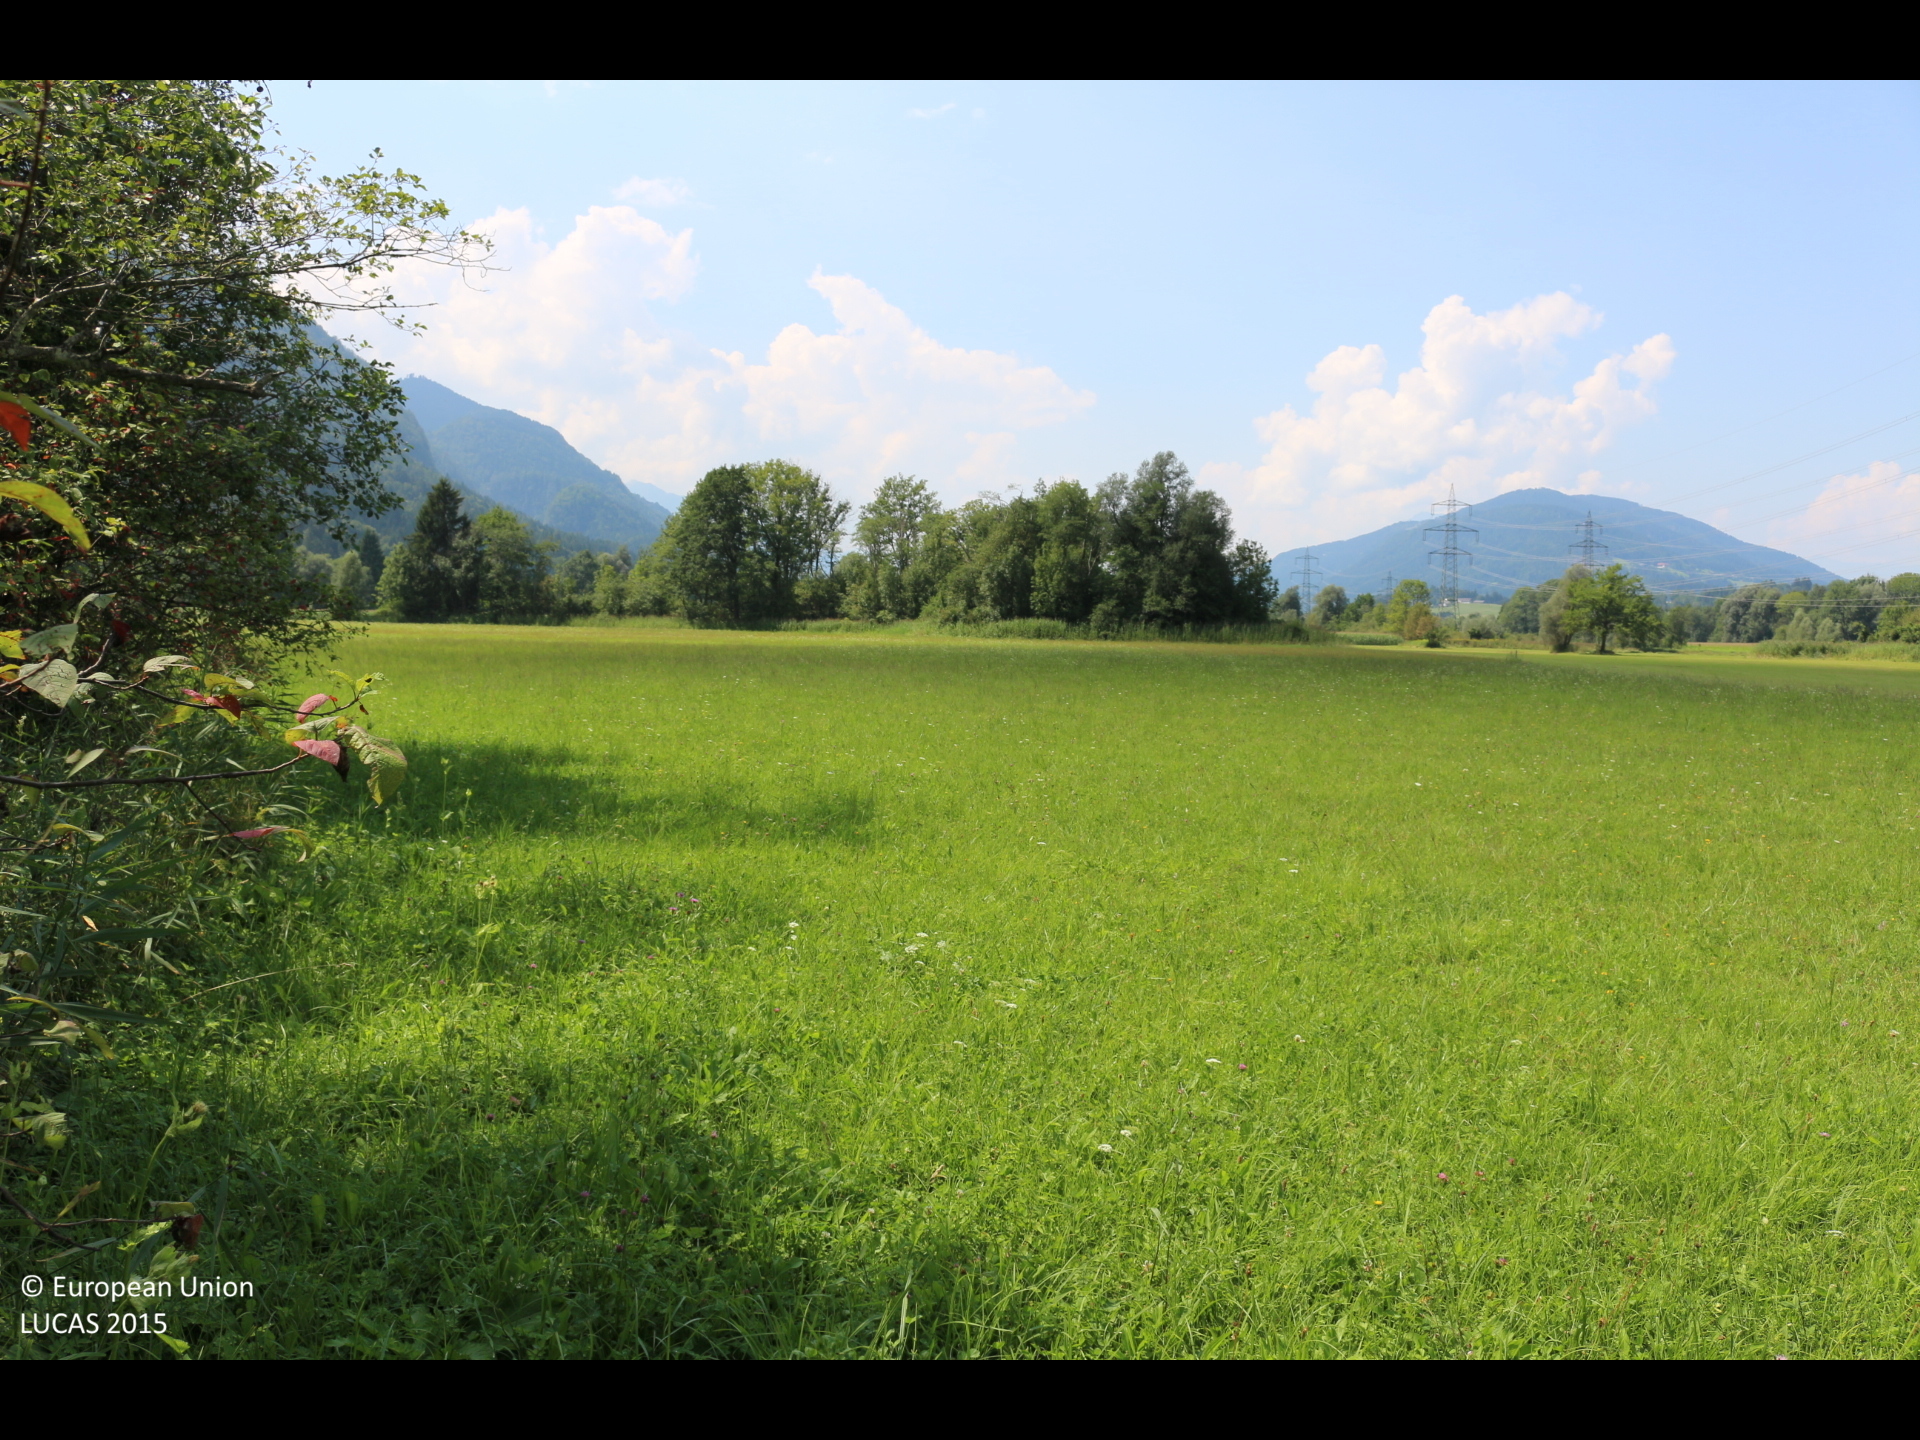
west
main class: Grassland
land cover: Grassland without tree/shrub cover
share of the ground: > 75 %
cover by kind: herbaceous plants 100 %
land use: Agriculture (excluding fallow land and kitchen gardens)
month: August
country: AT
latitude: 46.6035
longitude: 13.4045
